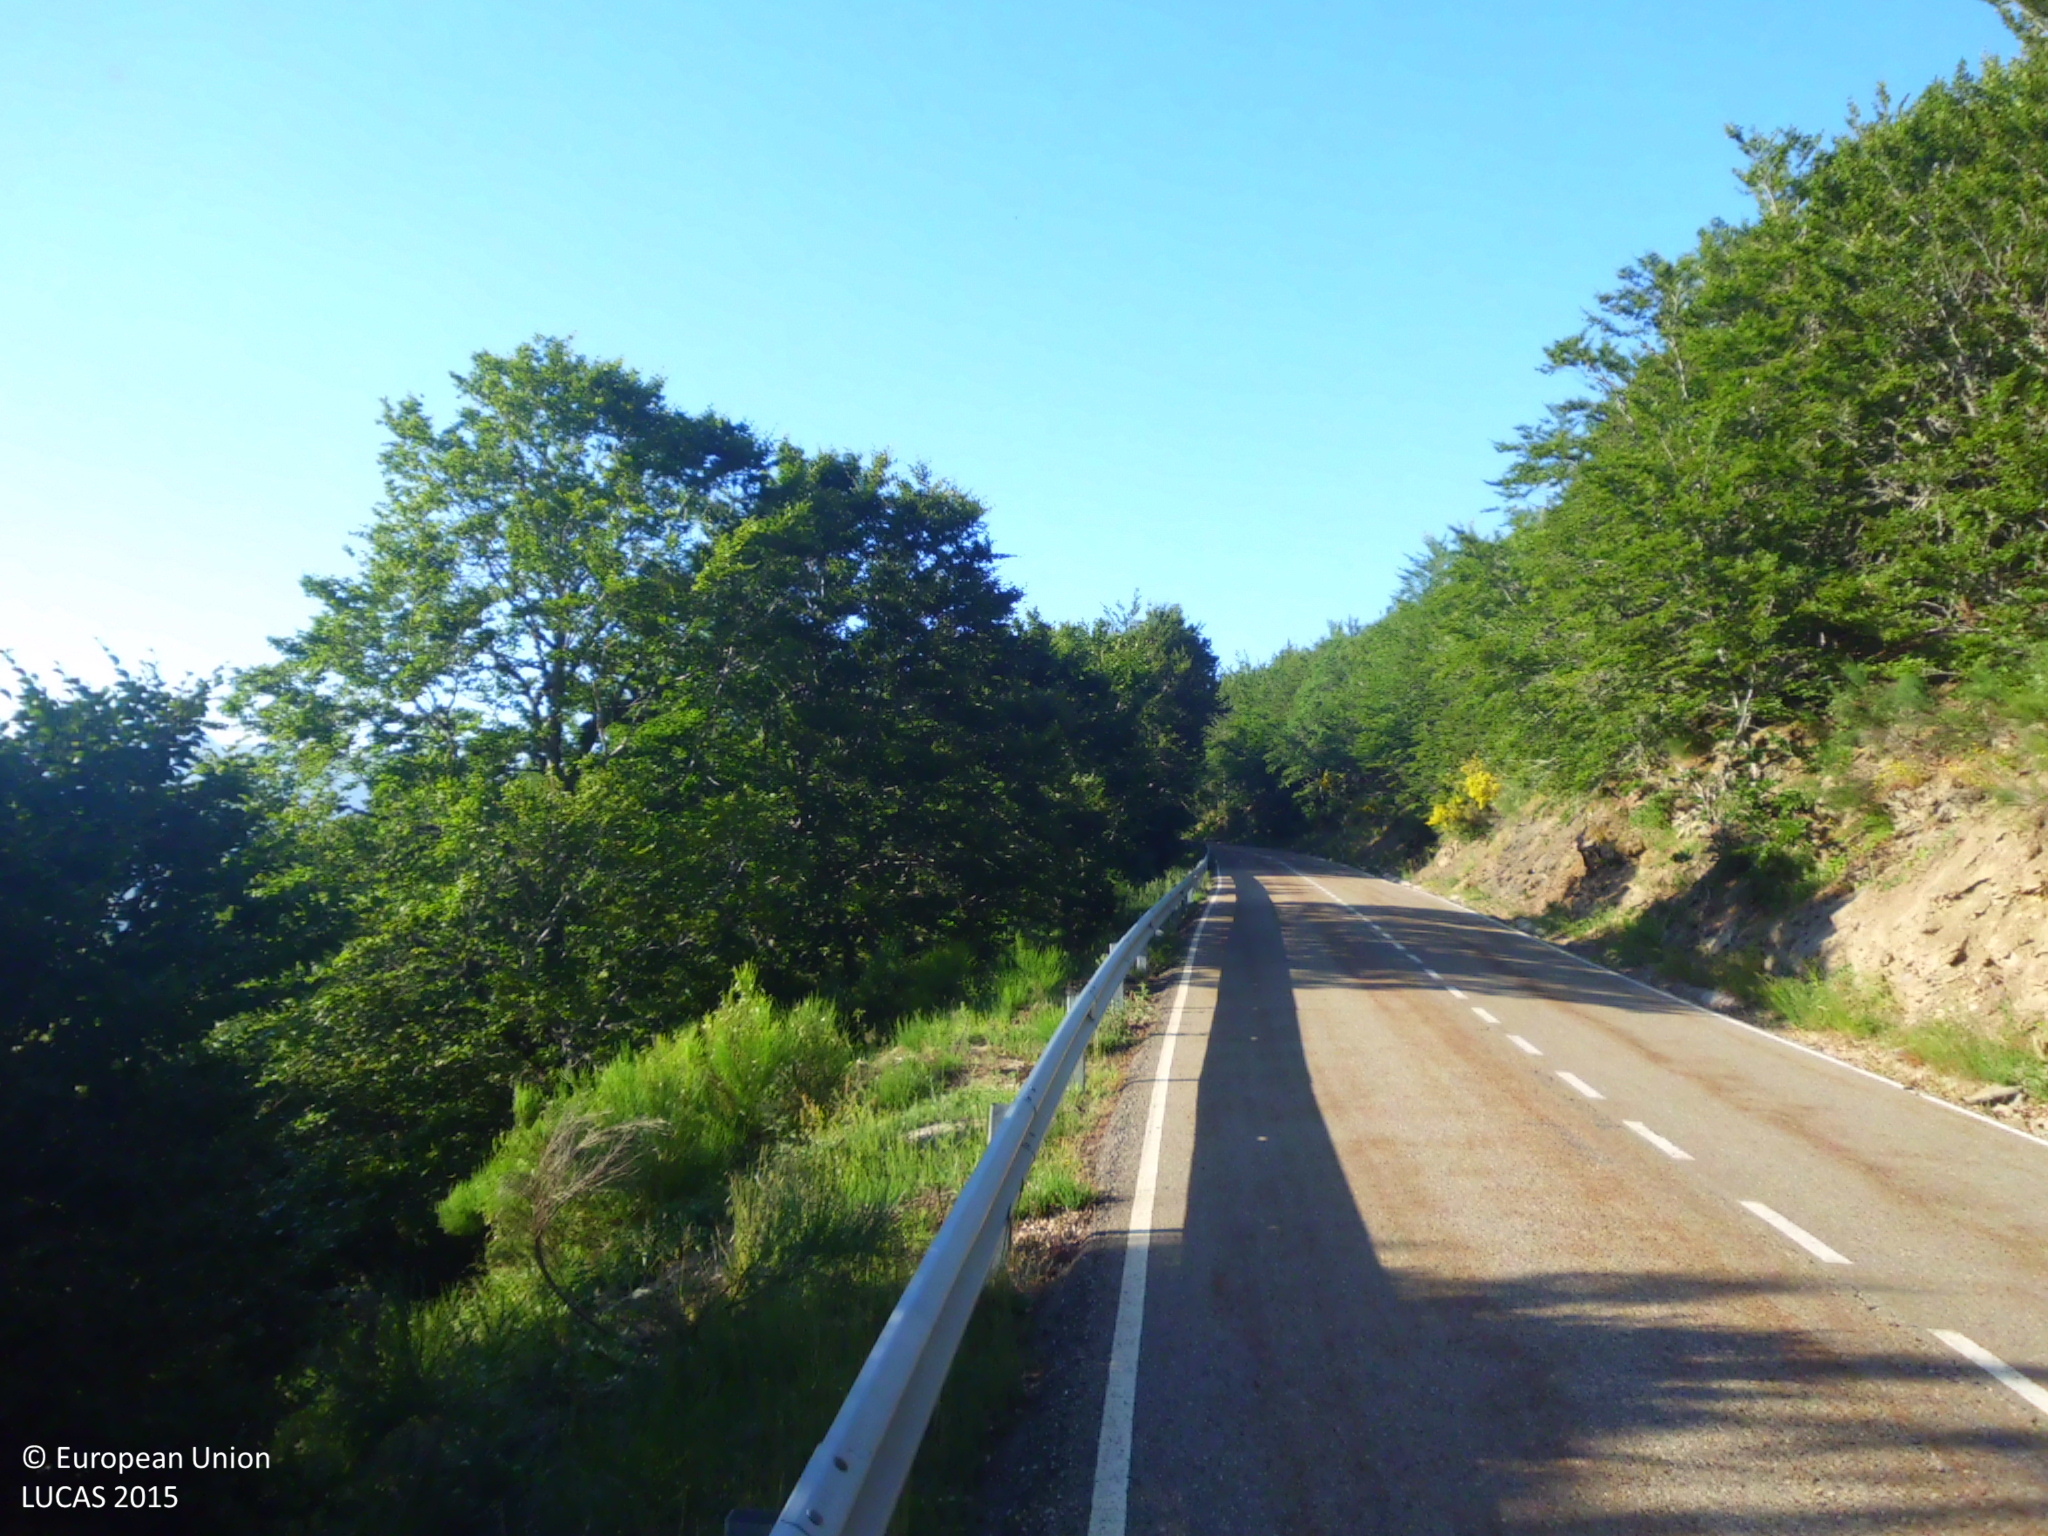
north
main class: Woodland
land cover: Broadleaved woodland
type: acidophilous oak and oak-birch forest
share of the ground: > 75 %
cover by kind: broadleaved forest trees 95 %, herbaceous plants 5 %
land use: Semi-natural and natural areas not in use
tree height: > 5 m
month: June
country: ES
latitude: 42.9303
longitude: -4.9514
